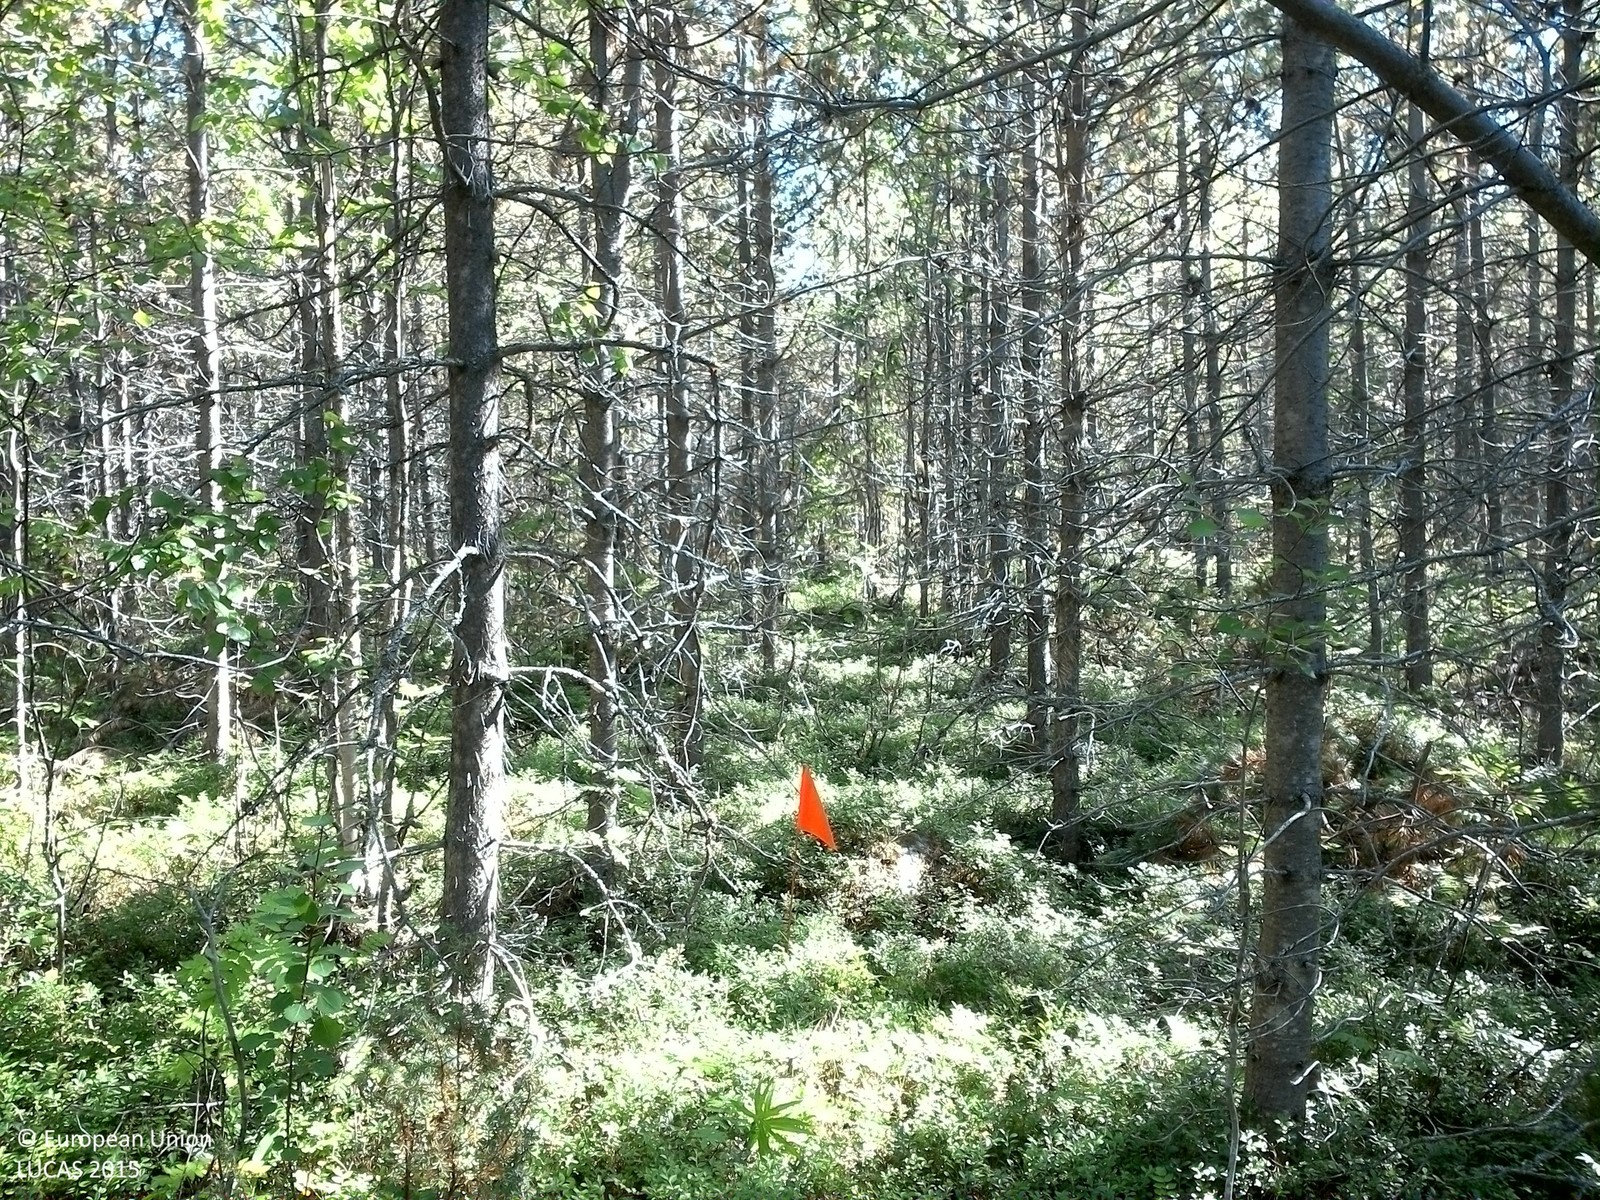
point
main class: Woodland
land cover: Pine dominated coniferous woodland
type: exotic forest
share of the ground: > 75 %
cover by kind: coniferous forest trees 80 %, shrubs 20 %
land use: Forestry
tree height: > 5 m
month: August
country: SE
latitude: 63.9267
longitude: 17.5776
